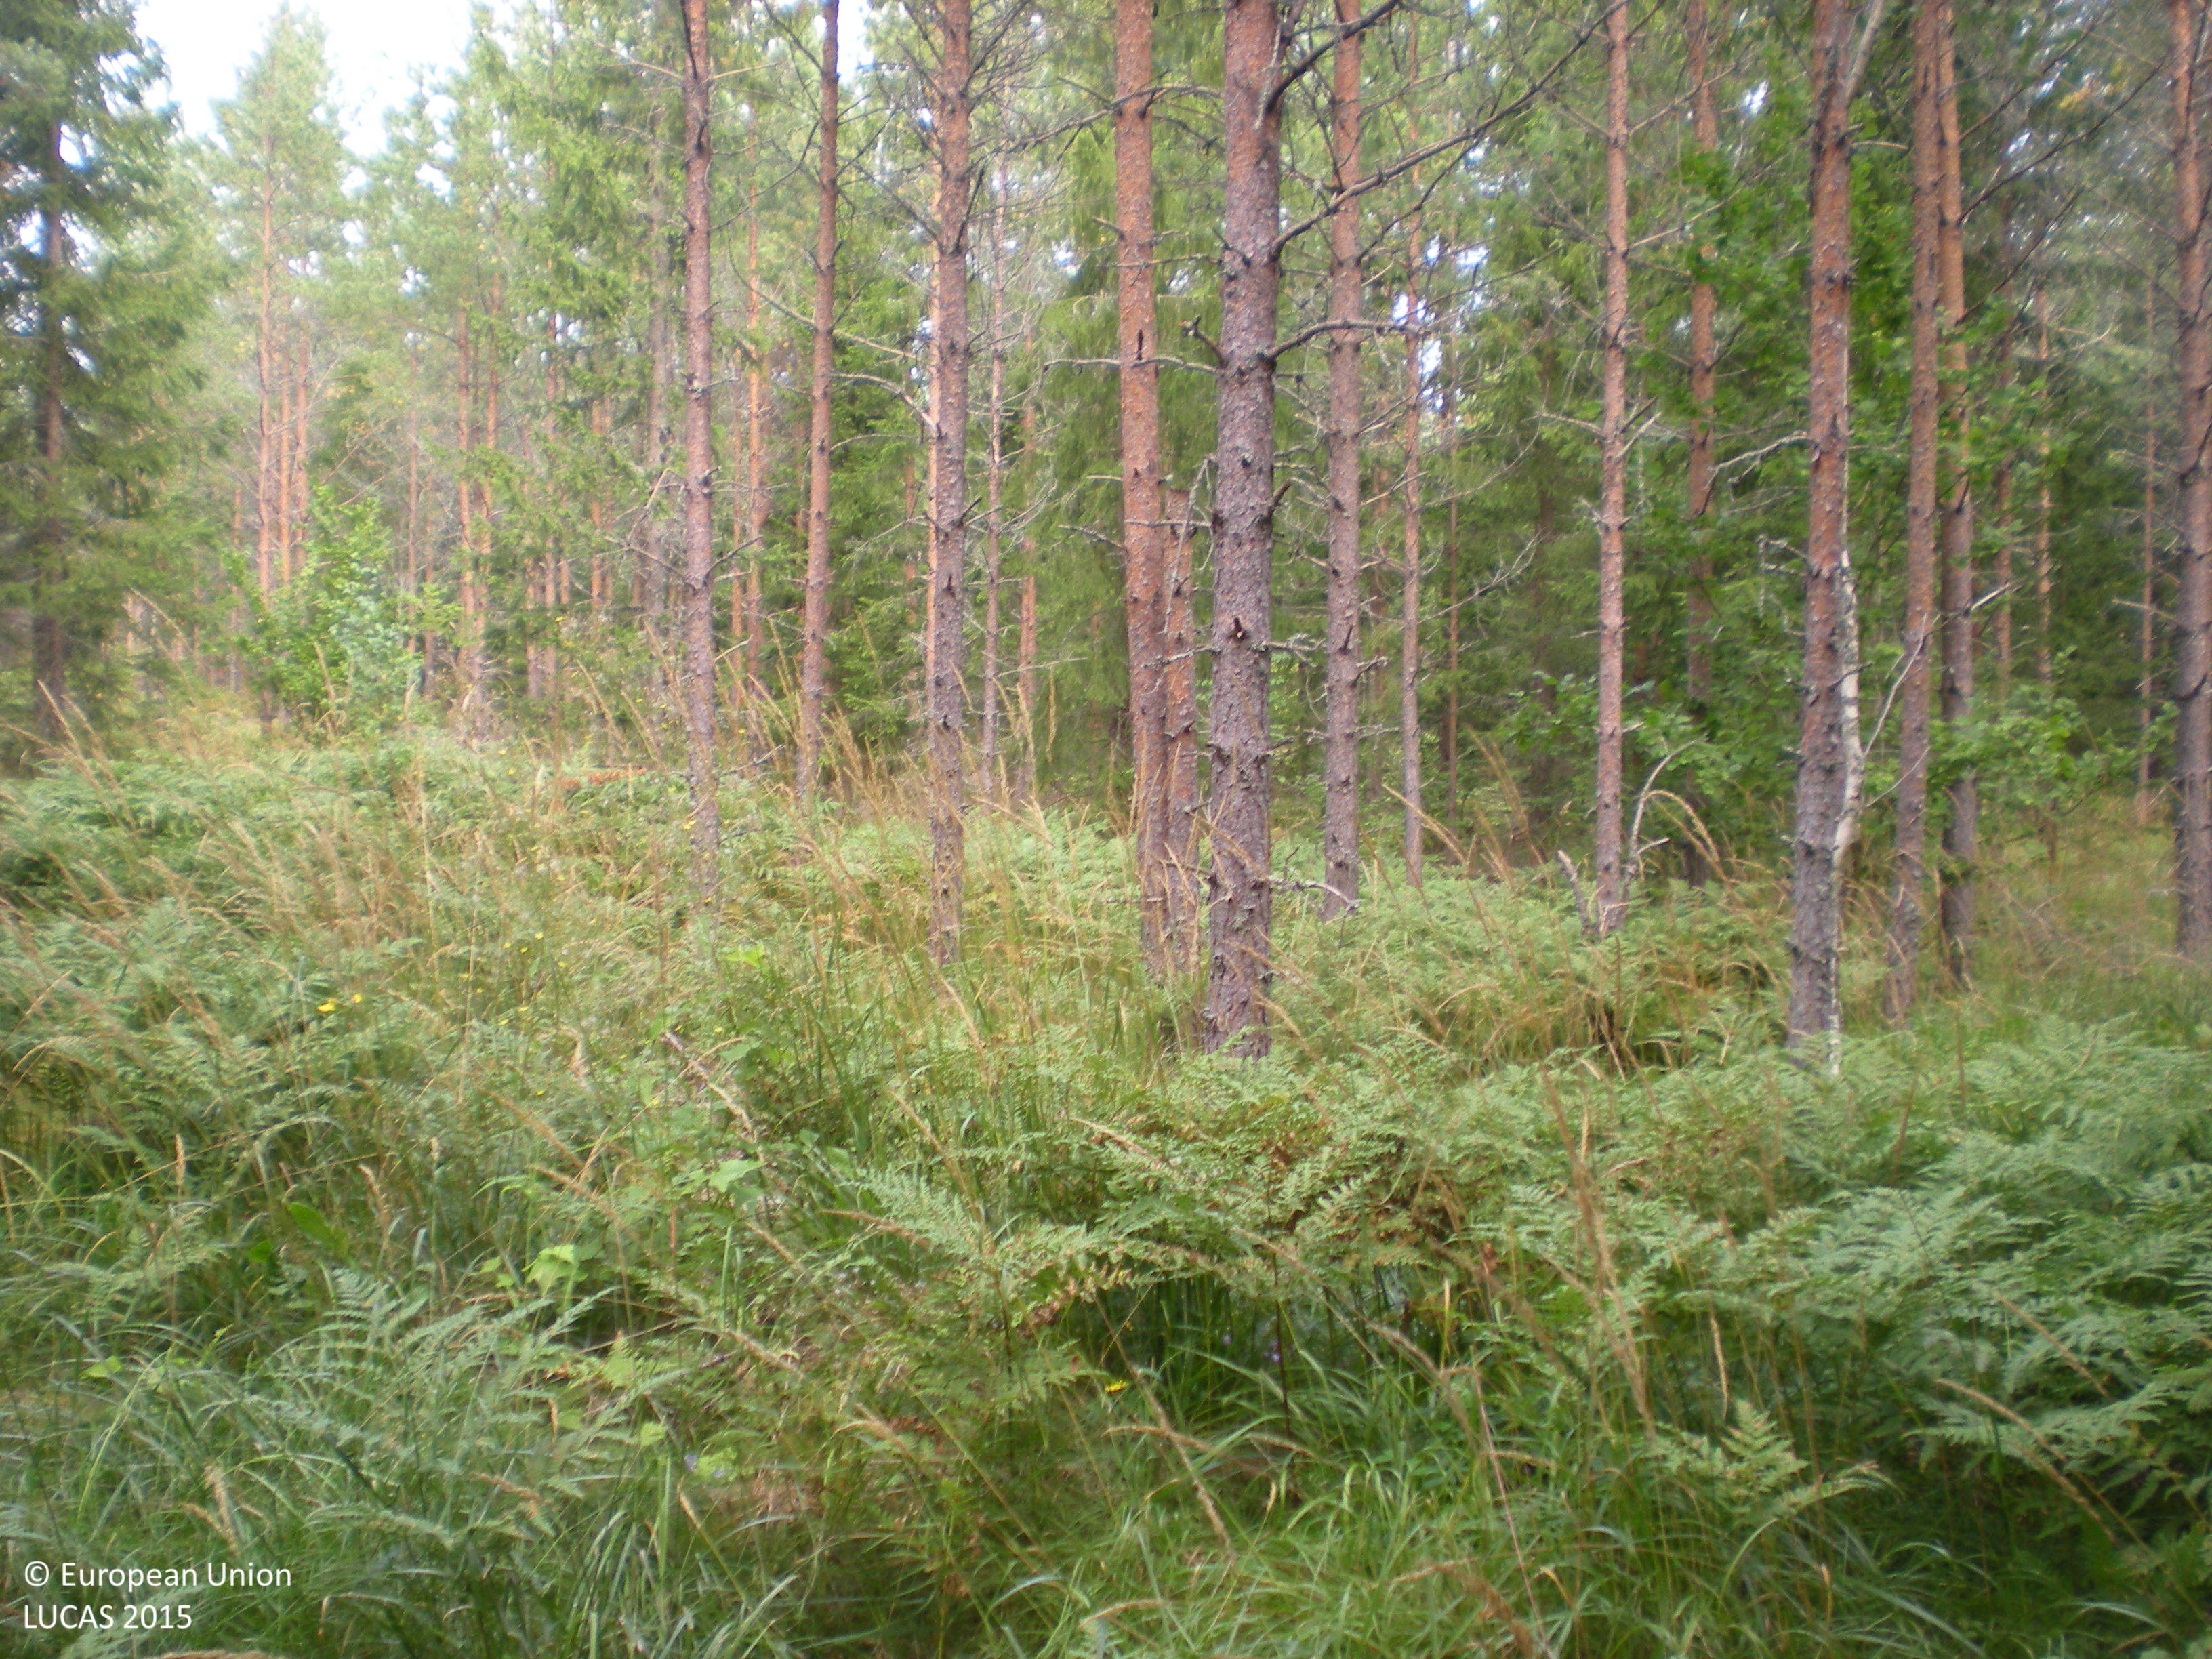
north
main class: Woodland
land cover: Other coniferous woodland
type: boreal forest
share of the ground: 50 - 75 %
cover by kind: coniferous forest trees 65 %, herbaceous plants 20 %, broadleaved forest trees 5 %, shrubs 5 %, lichens and mosses 5 %
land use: Forestry
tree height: > 5 m
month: August
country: SE
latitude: 60.4637
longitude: 17.6110
